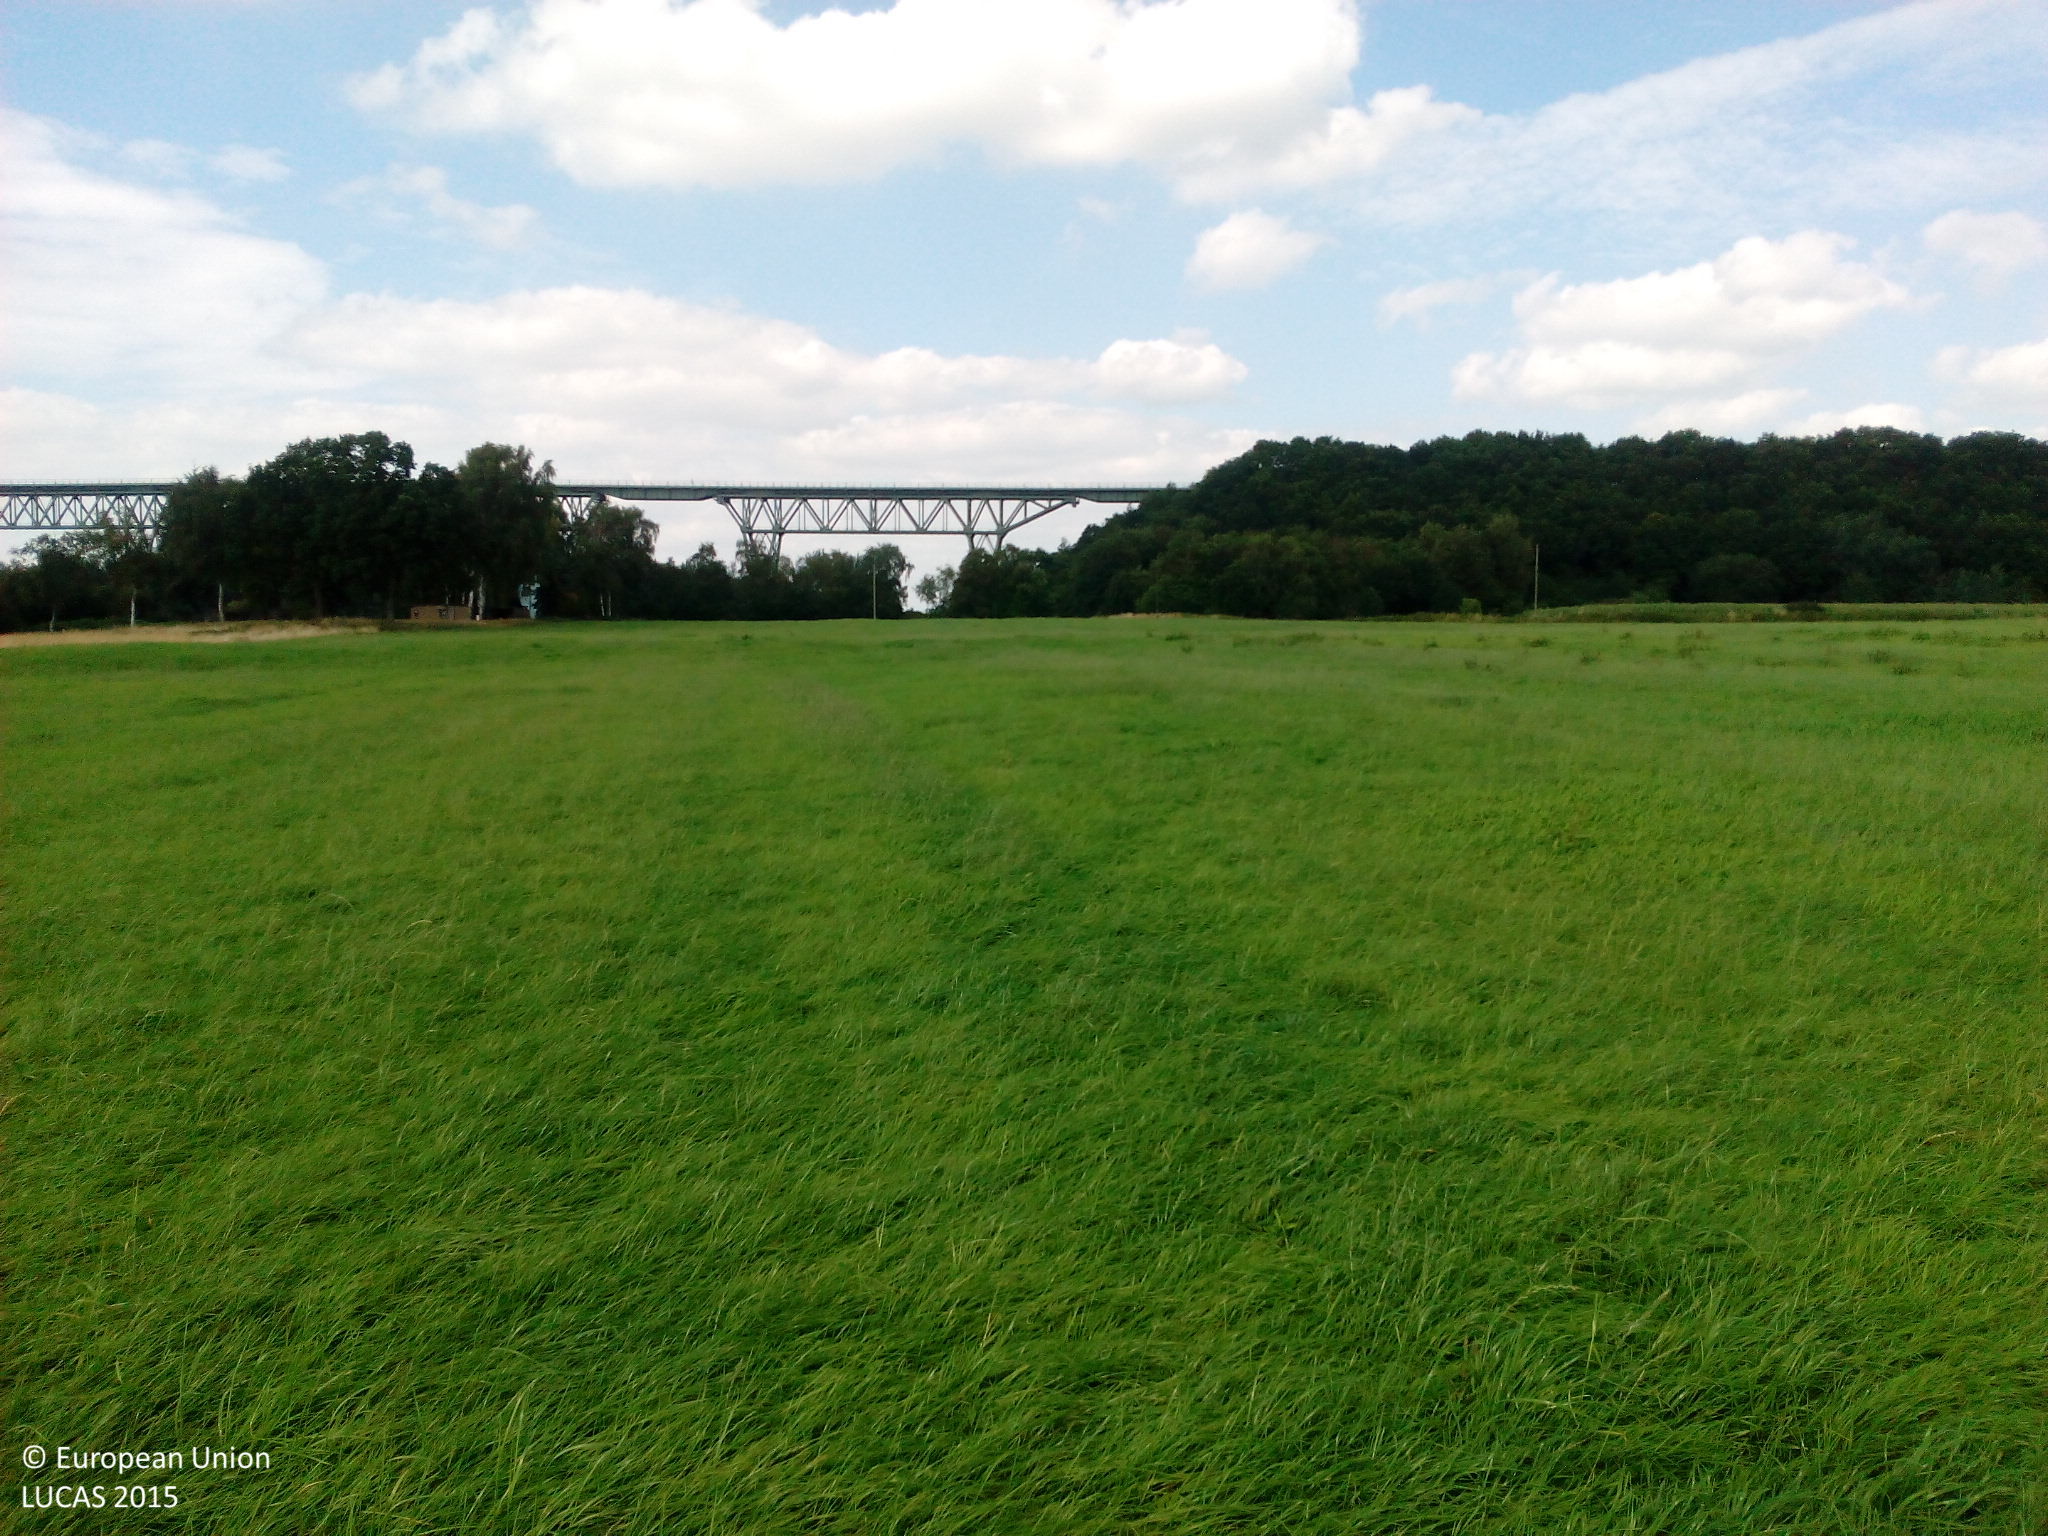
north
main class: Grassland
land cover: Grassland without tree/shrub cover
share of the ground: > 75 %
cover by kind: herbaceous plants 100 %
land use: Agriculture (excluding fallow land and kitchen gardens)
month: August
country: DE
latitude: 54.0110
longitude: 9.3137
